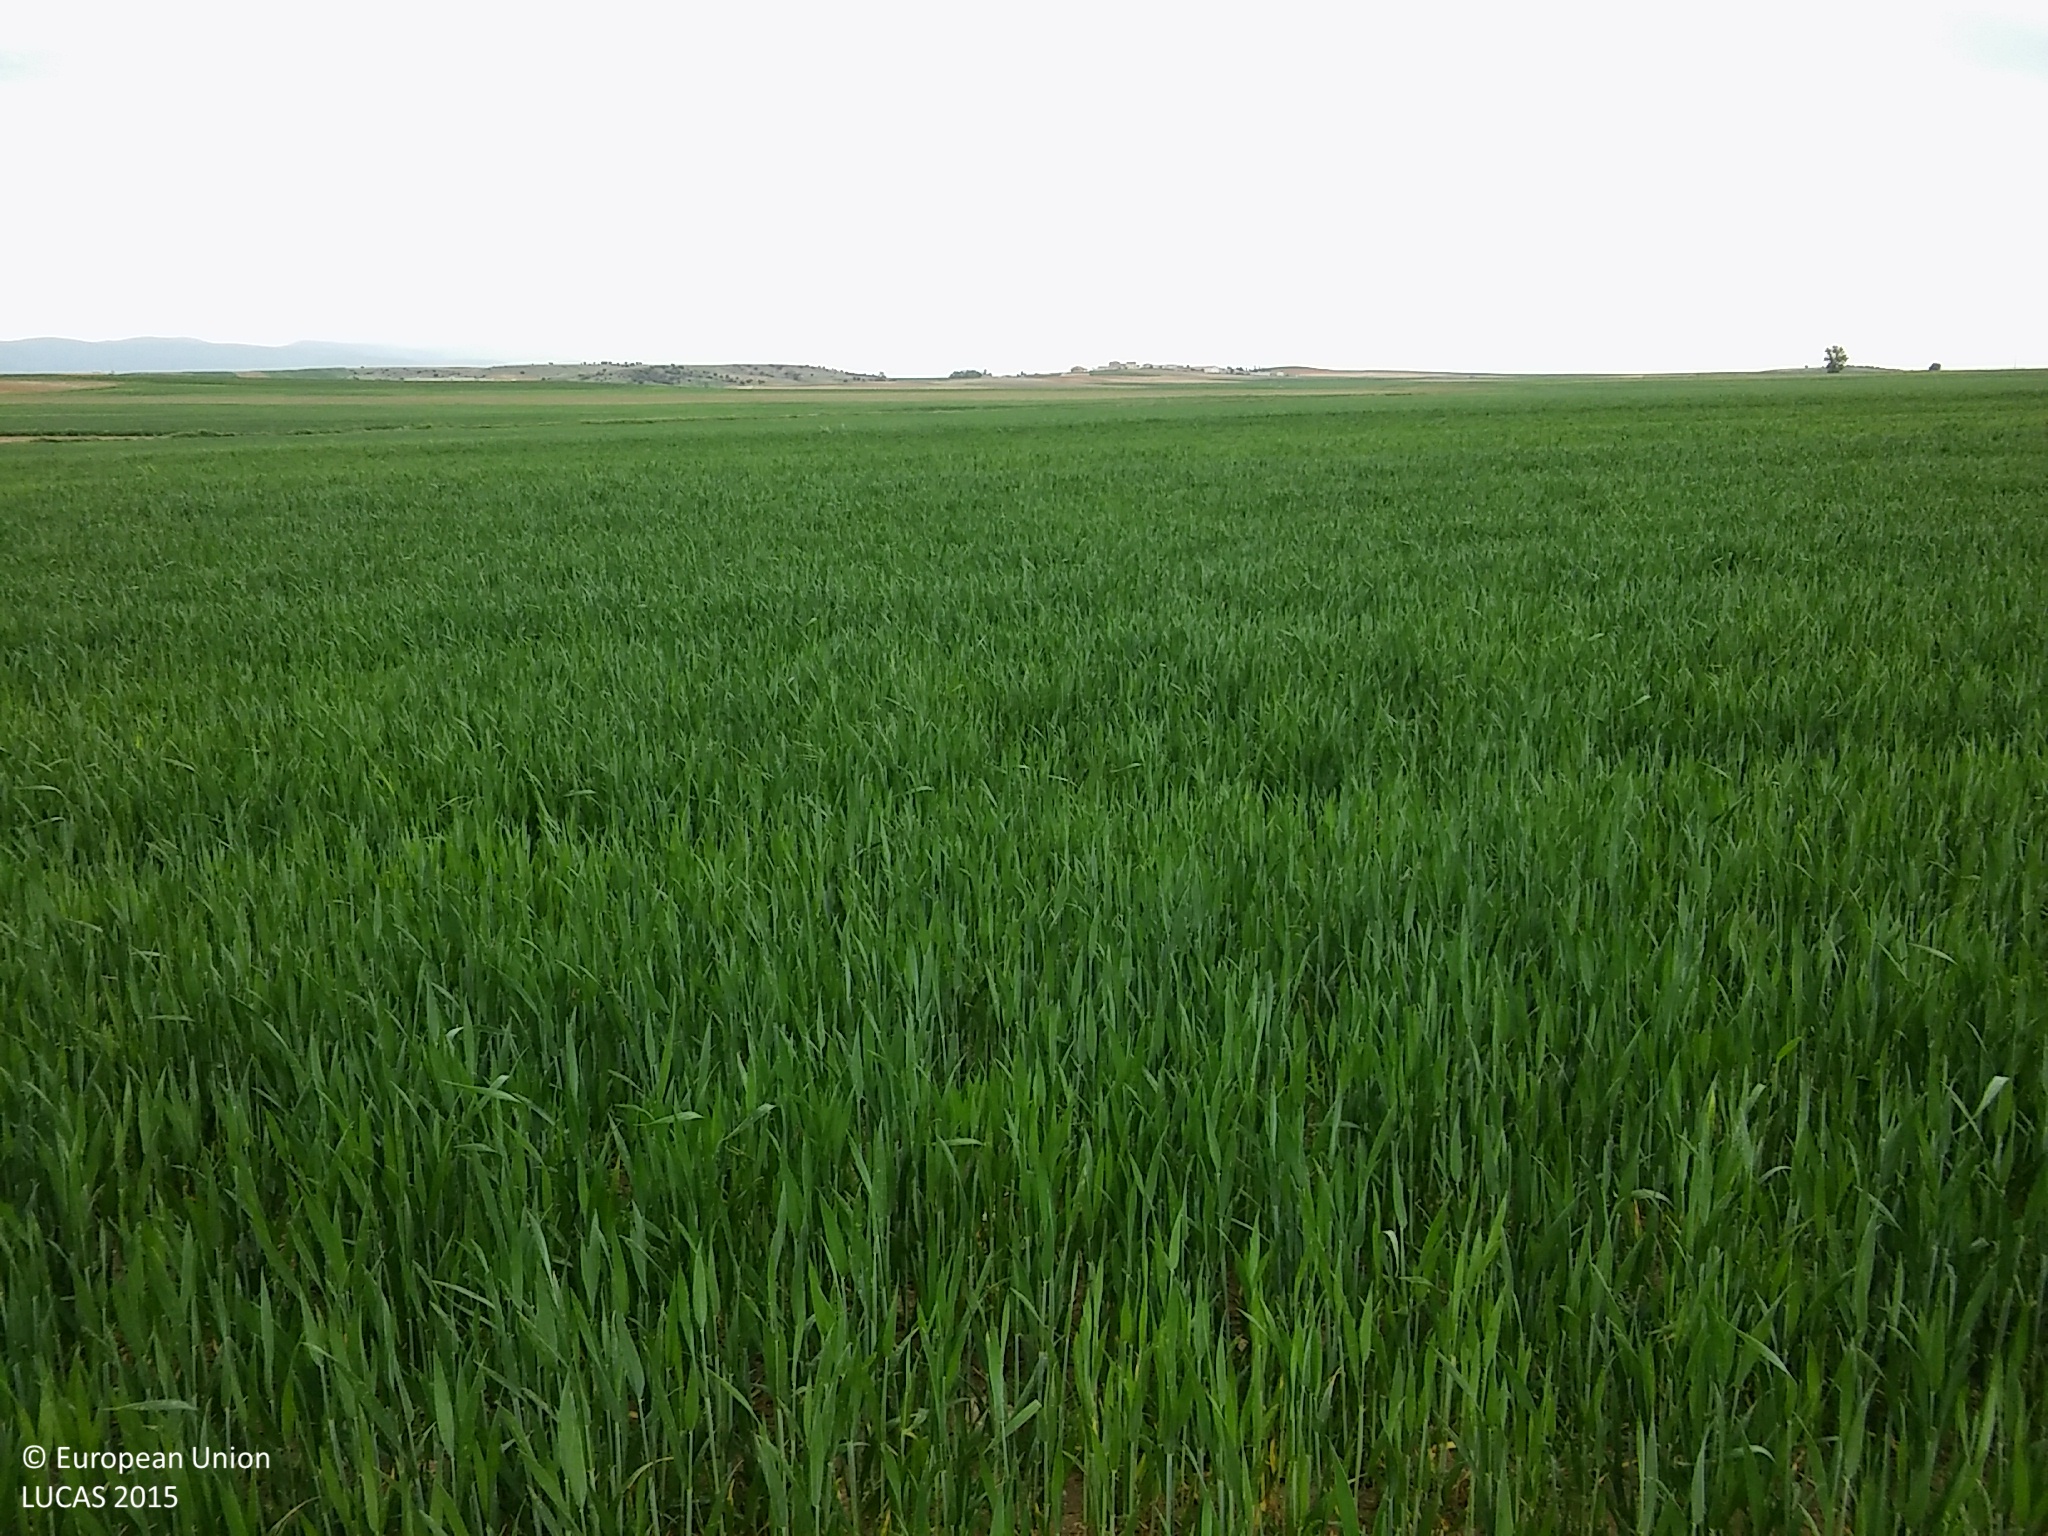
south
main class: Cropland
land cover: Common wheat
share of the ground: 50 - 75 %
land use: Agriculture (excluding fallow land and kitchen gardens)
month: May
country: ES
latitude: 41.1559
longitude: -4.0540
